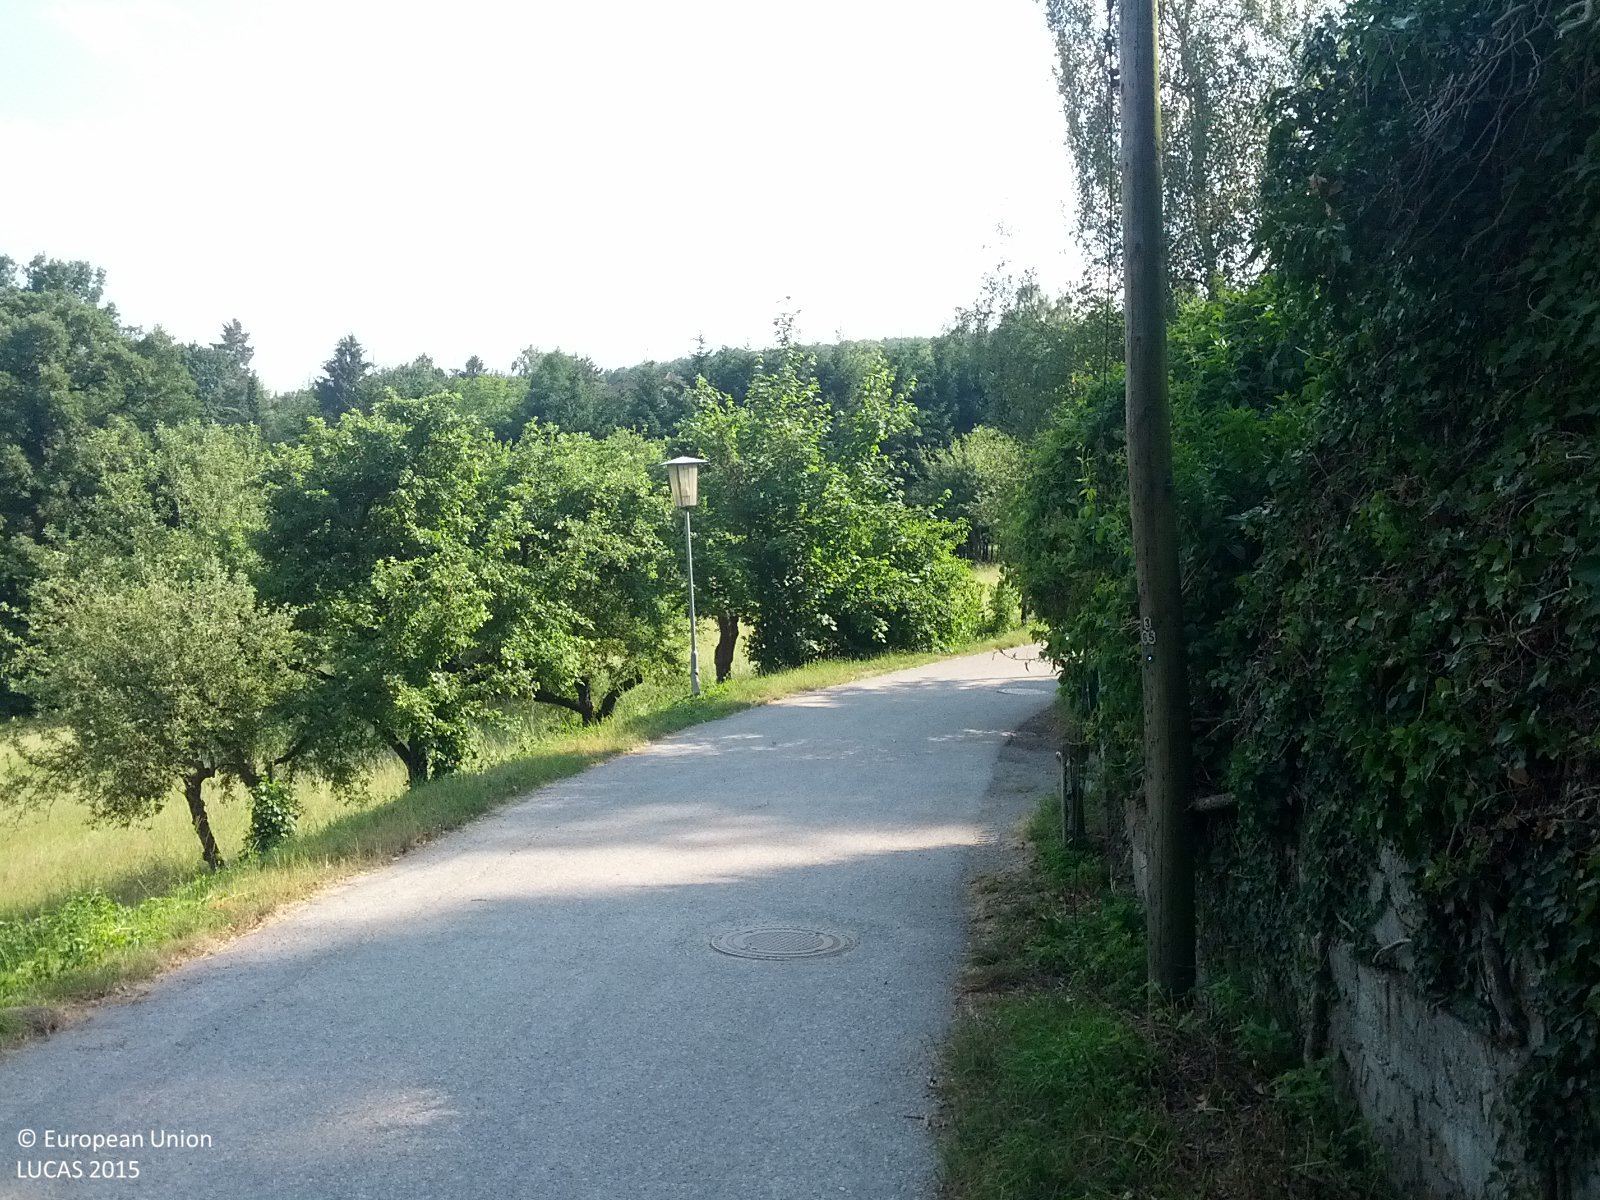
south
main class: Shrubland
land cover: Shrubland without tree cover
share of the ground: > 75 %
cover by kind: shrubs 70 %, herbaceous plants 20 %, lichens and mosses 10 %
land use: Abandoned areas
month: June
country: AT
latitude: 48.1811
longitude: 16.0967
